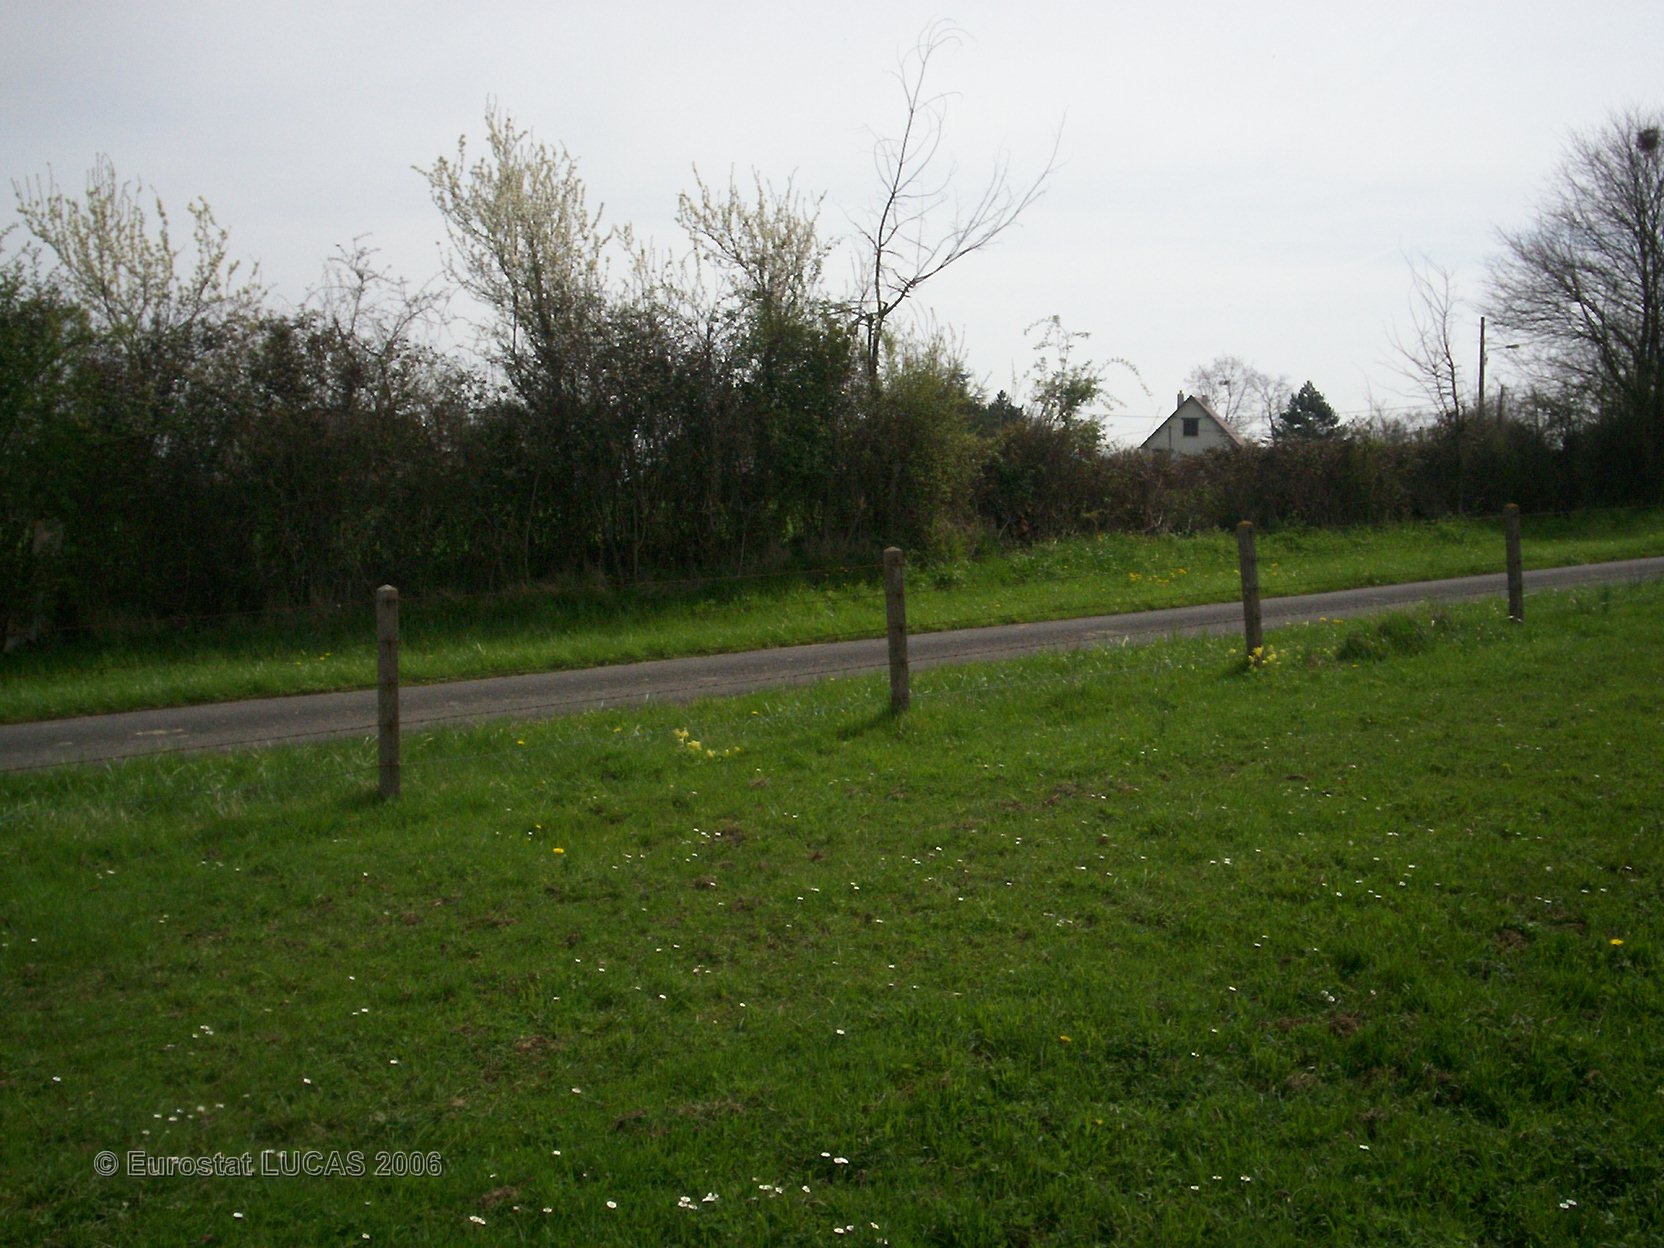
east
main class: Grassland
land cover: Grassland without tree/shrub cover
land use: Agriculture (excluding fallow land and kitchen gardens)
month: April
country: FR
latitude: 49.0291
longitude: -0.0841
